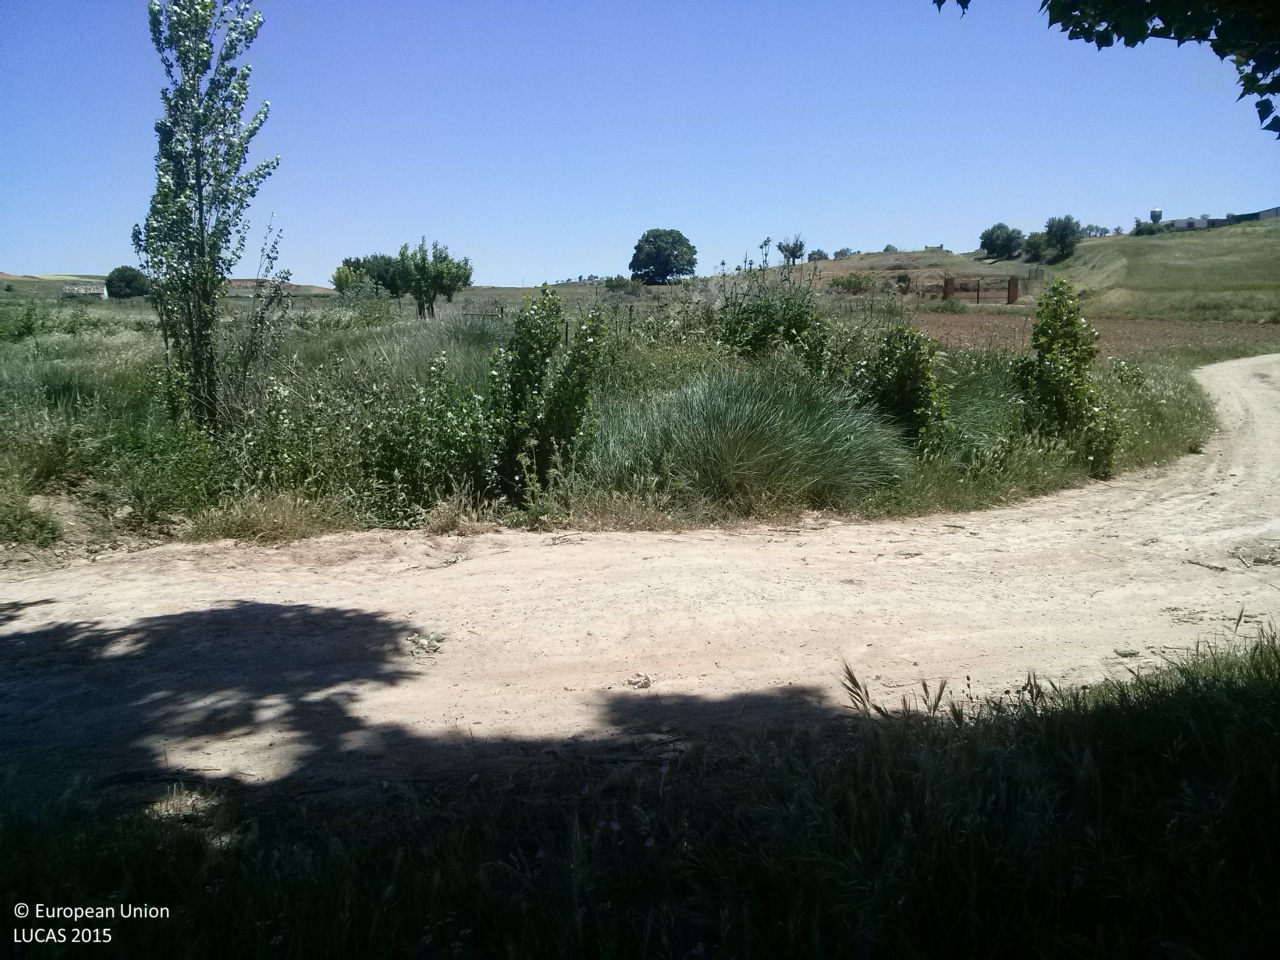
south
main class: Grassland
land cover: Grassland with sparse tree/shrub cover
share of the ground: 50 - 75 %
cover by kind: herbaceous plants 60 %, unconsolidated bare surface 35 %, broadleaved forest trees 5 %
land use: Abandoned areas
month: May
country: ES
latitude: 40.3639
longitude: -2.7553
